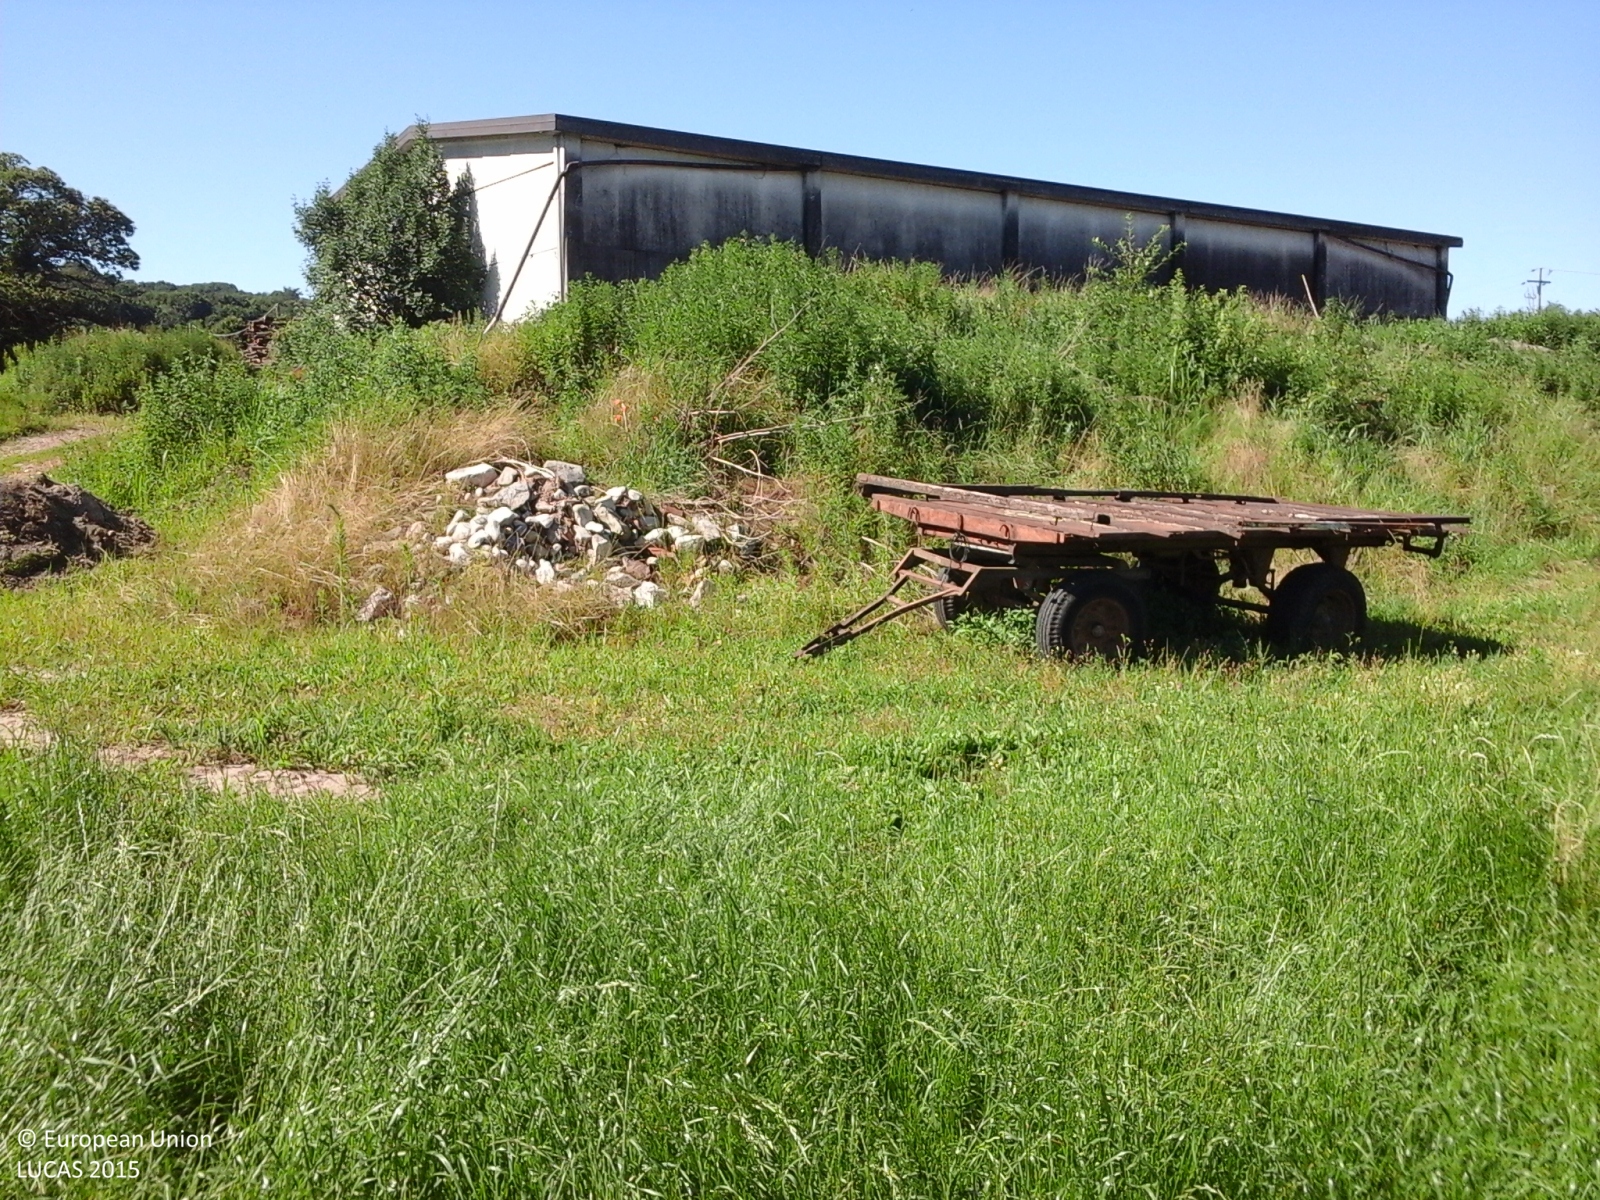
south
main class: Grassland
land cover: Grassland without tree/shrub cover
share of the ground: > 75 %
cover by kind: herbaceous plants 100 %
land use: Agriculture (excluding fallow land and kitchen gardens)
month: June
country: IT
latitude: 45.7838
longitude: 8.6258
